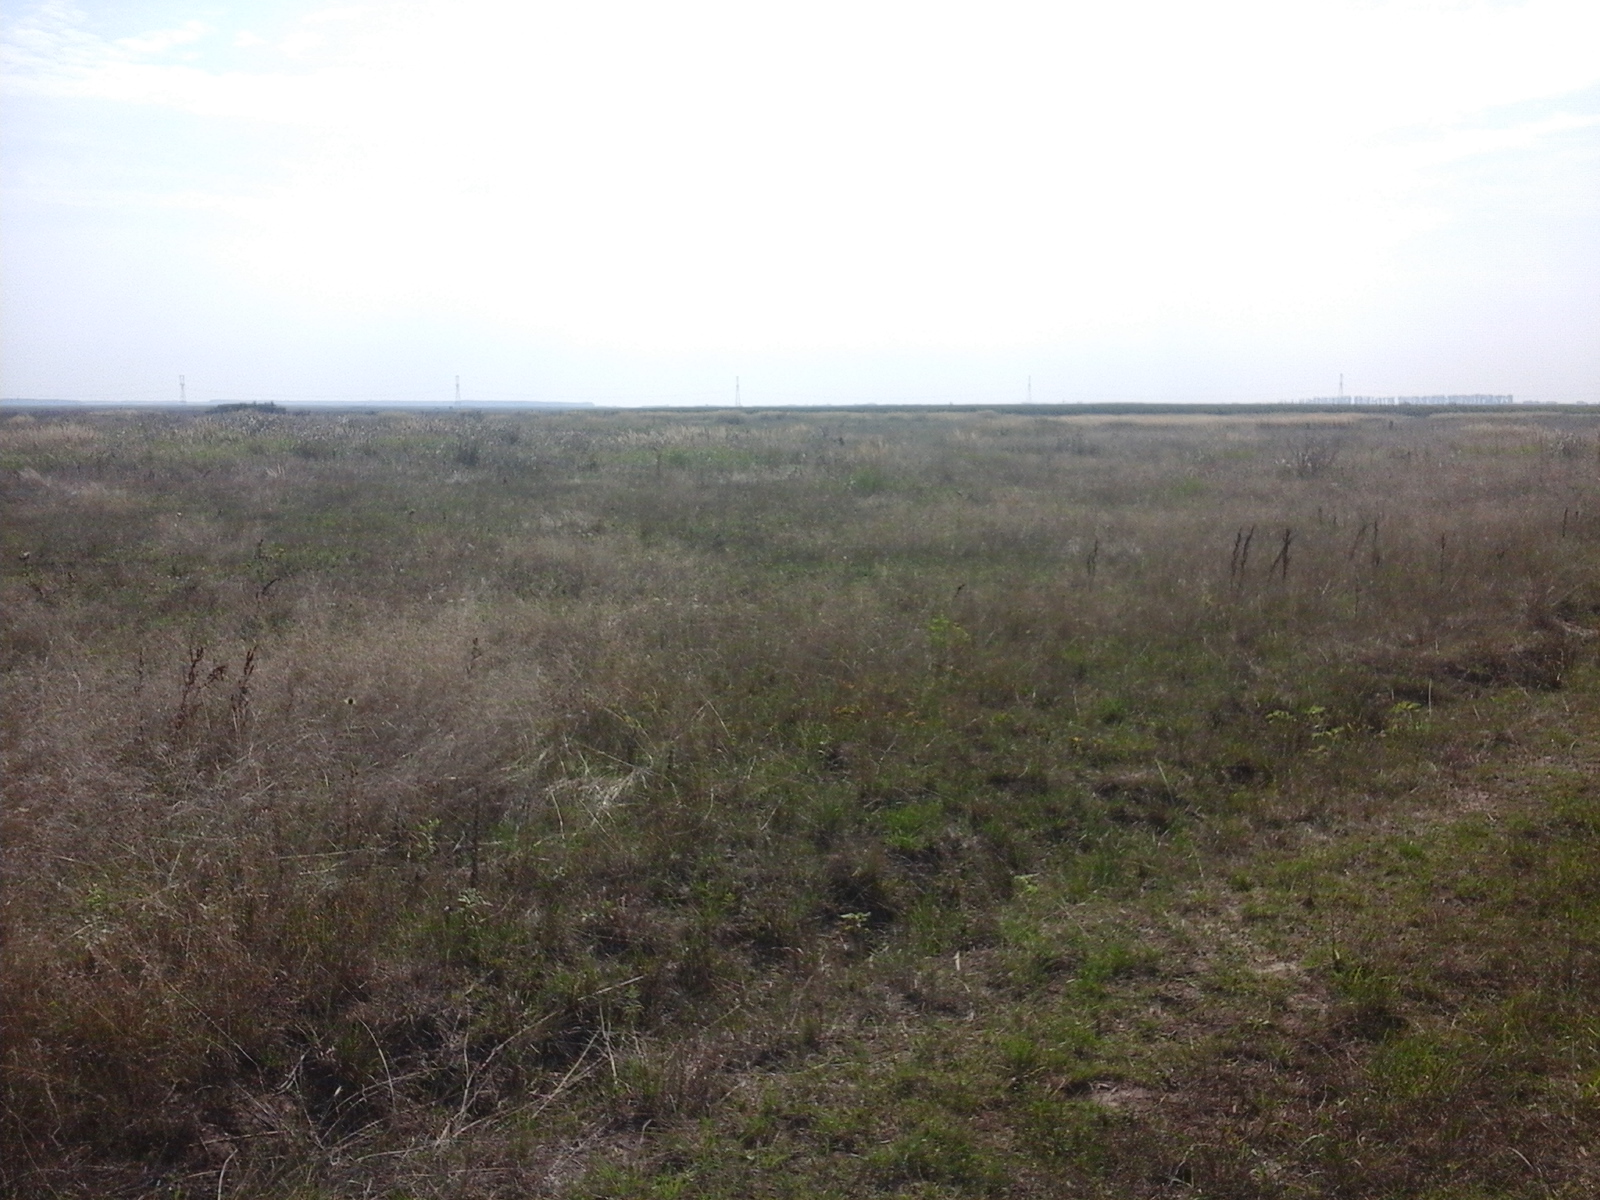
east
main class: Cropland
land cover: Maize
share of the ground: > 75 %
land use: Agriculture (excluding fallow land and kitchen gardens)
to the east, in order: Maize; Tracks; Spontaneously vegetated surfaces
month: August
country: RO
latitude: 46.5413
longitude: 21.5531
